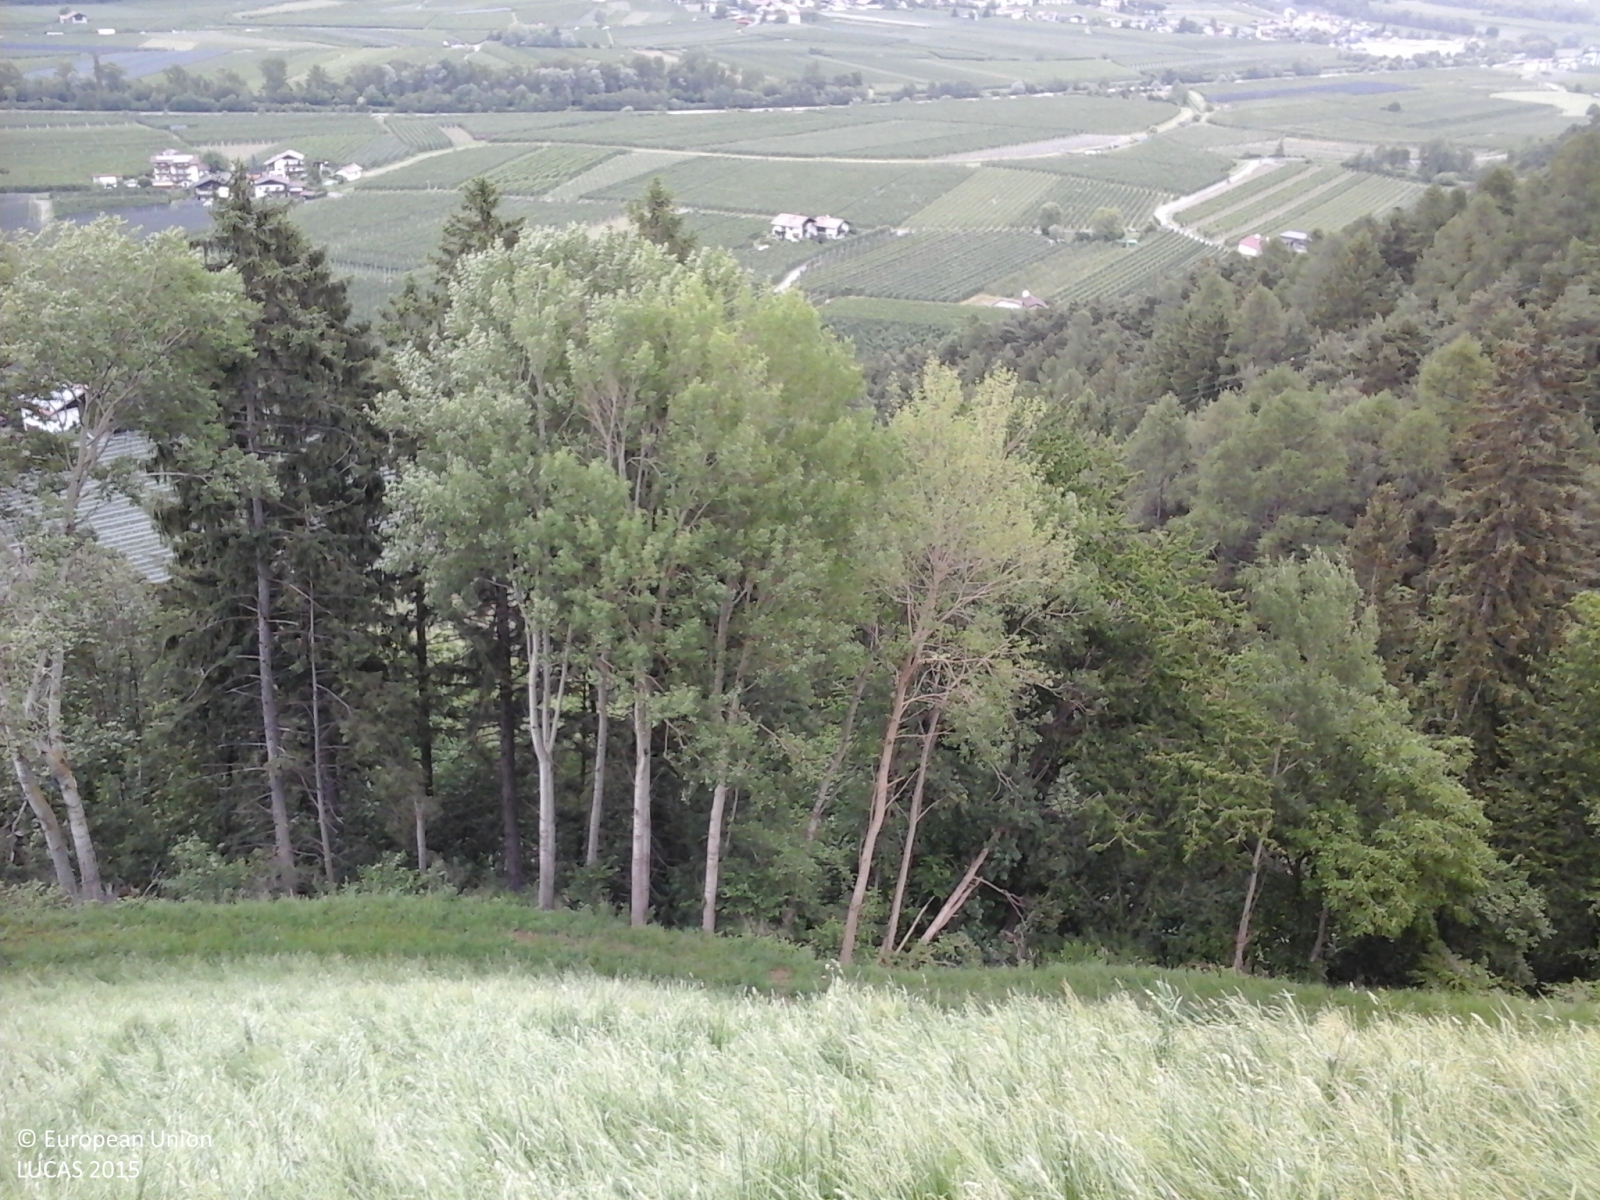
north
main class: Grassland
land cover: Grassland without tree/shrub cover
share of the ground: > 75 %
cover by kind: herbaceous plants 100 %
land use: Agriculture (excluding fallow land and kitchen gardens)
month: May
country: IT
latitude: 46.6522
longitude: 11.0572
